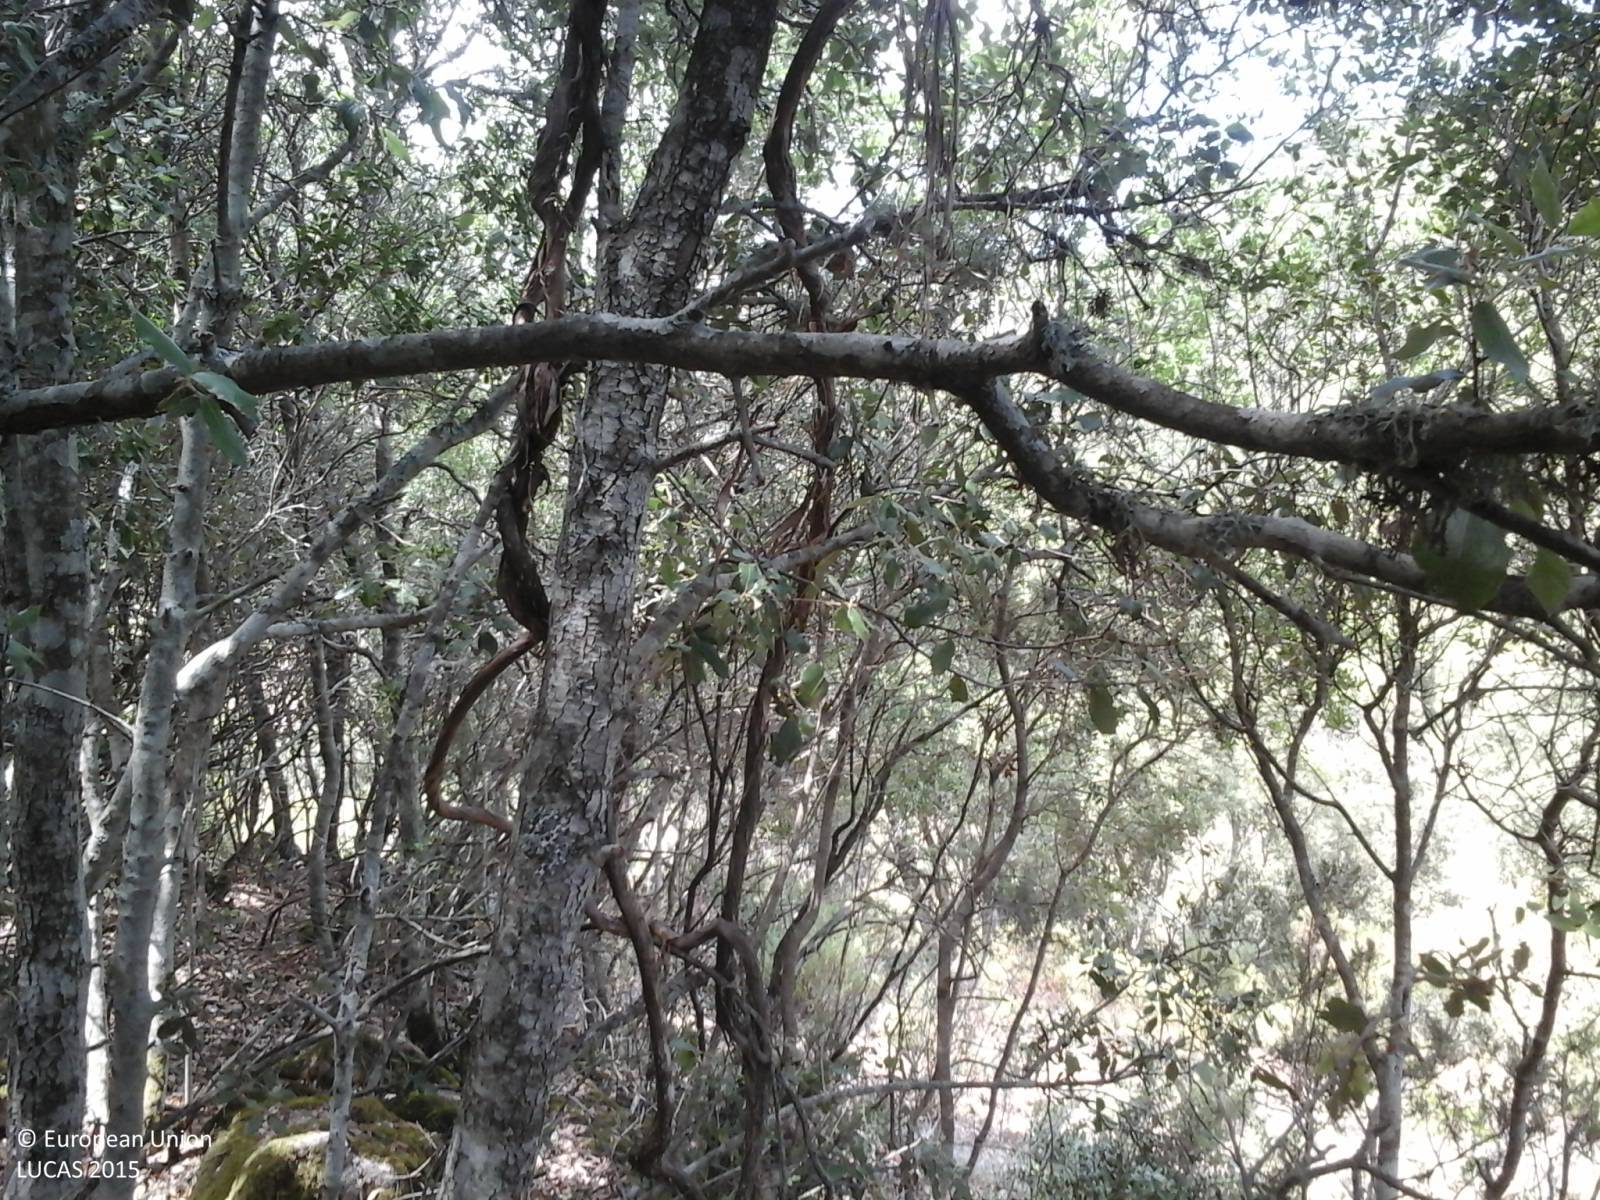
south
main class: Woodland
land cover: Broadleaved woodland
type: broadleaved evergreen forest
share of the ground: > 75 %
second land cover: Grassland without tree/shrub cover
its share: > 75 %
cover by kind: broadleaved forest trees 75 %, herbaceous plants 25 %
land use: Forestry
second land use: Agriculture (excluding fallow land and kitchen gardens)
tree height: > 5 m
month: June
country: IT
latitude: 40.6820
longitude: 9.4466
